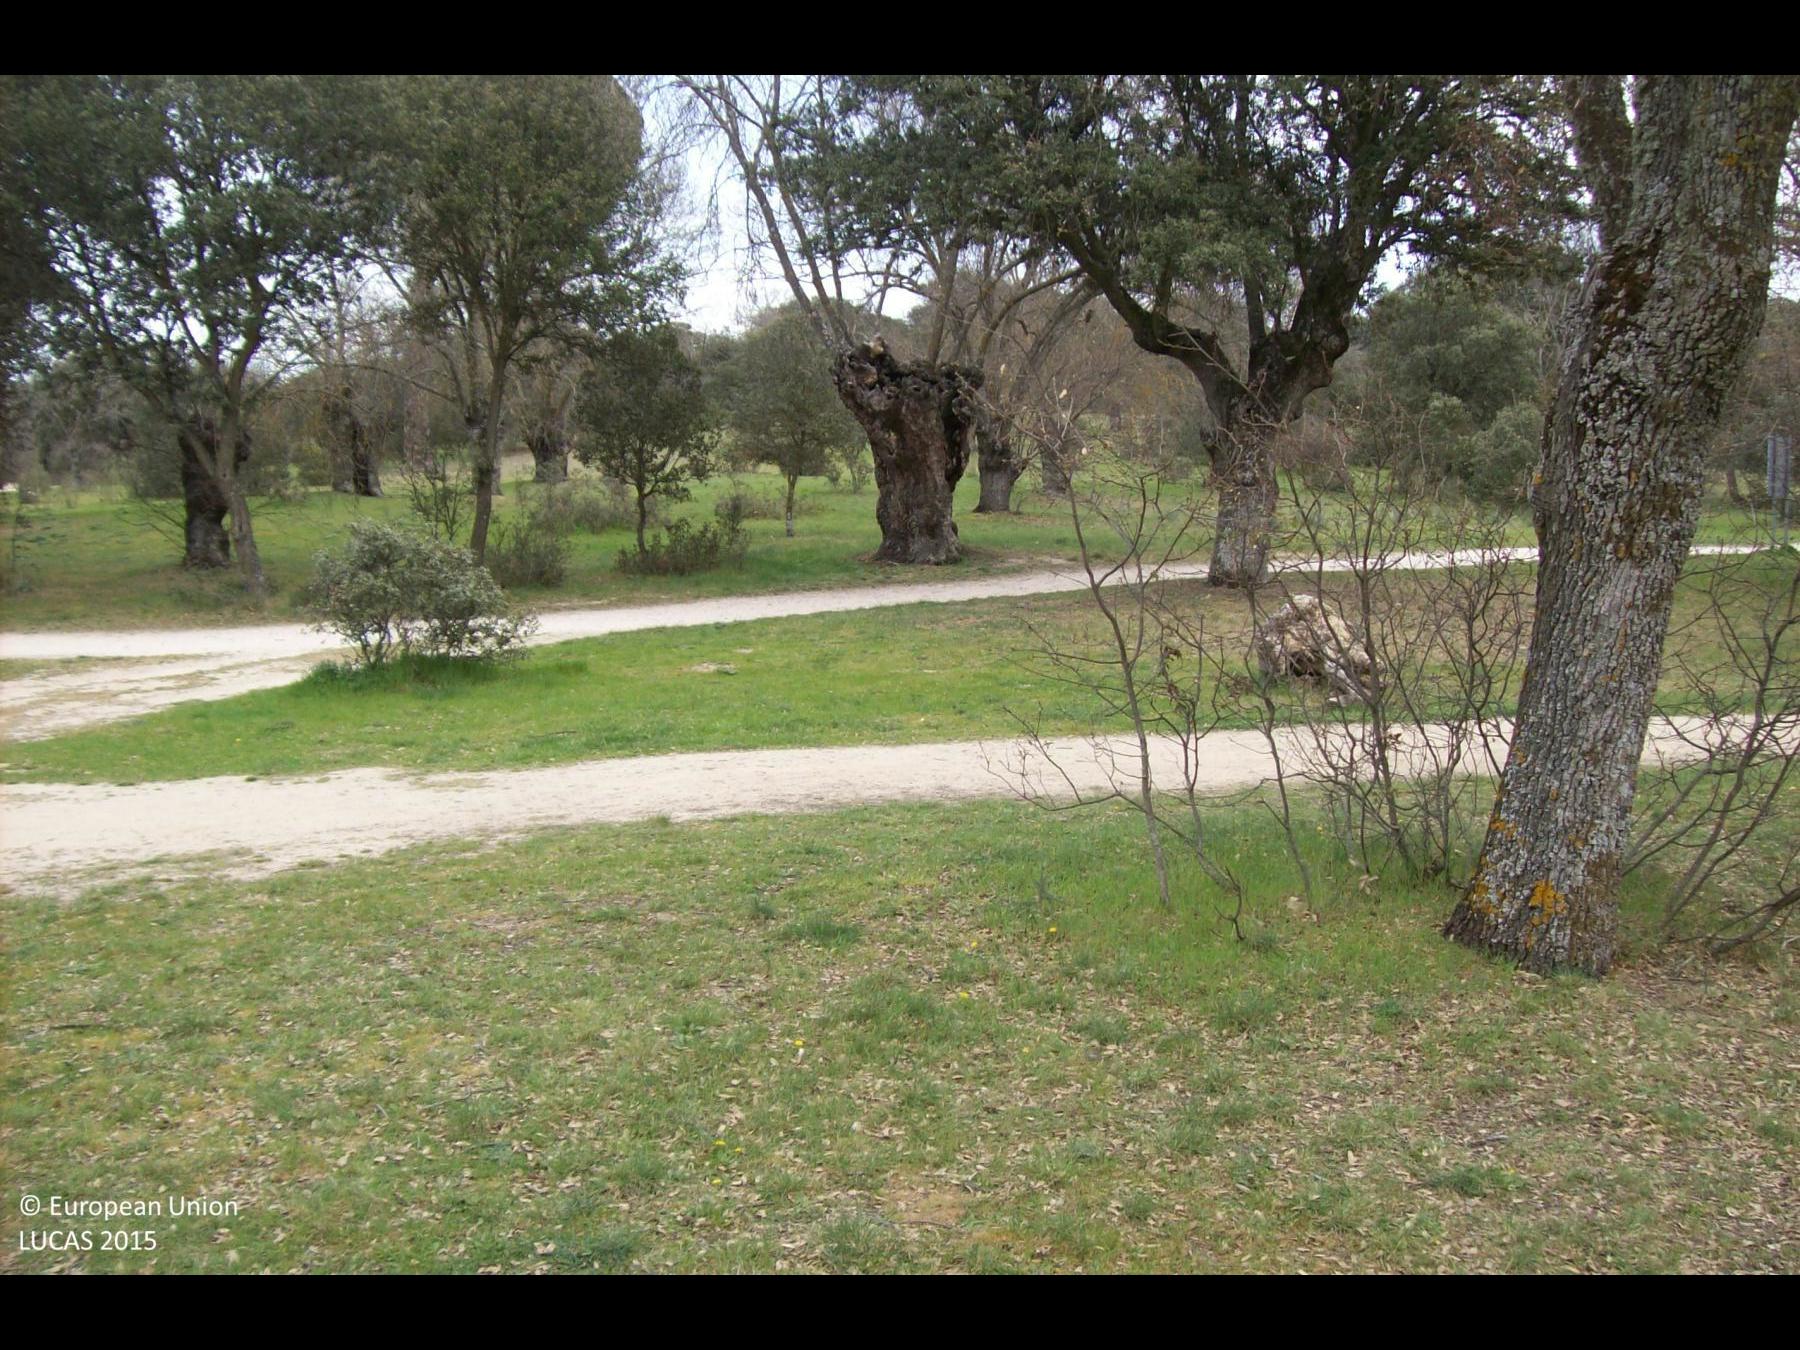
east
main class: Woodland
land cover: Broadleaved woodland
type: thermophilous deciduous forest
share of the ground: 25 - 50 %
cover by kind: broadleaved forest trees 45 %, herbaceous plants 45 %
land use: Amenities, museums, leisure
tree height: > 5 m
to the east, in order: Broadleaved woodland; Tracks; Broadleaved woodland; Tracks; Broadleaved woodland; Grassland with sparse tree/shrub cover; Broadleaved woodland
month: April
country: ES
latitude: 40.4139
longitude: -3.8632
